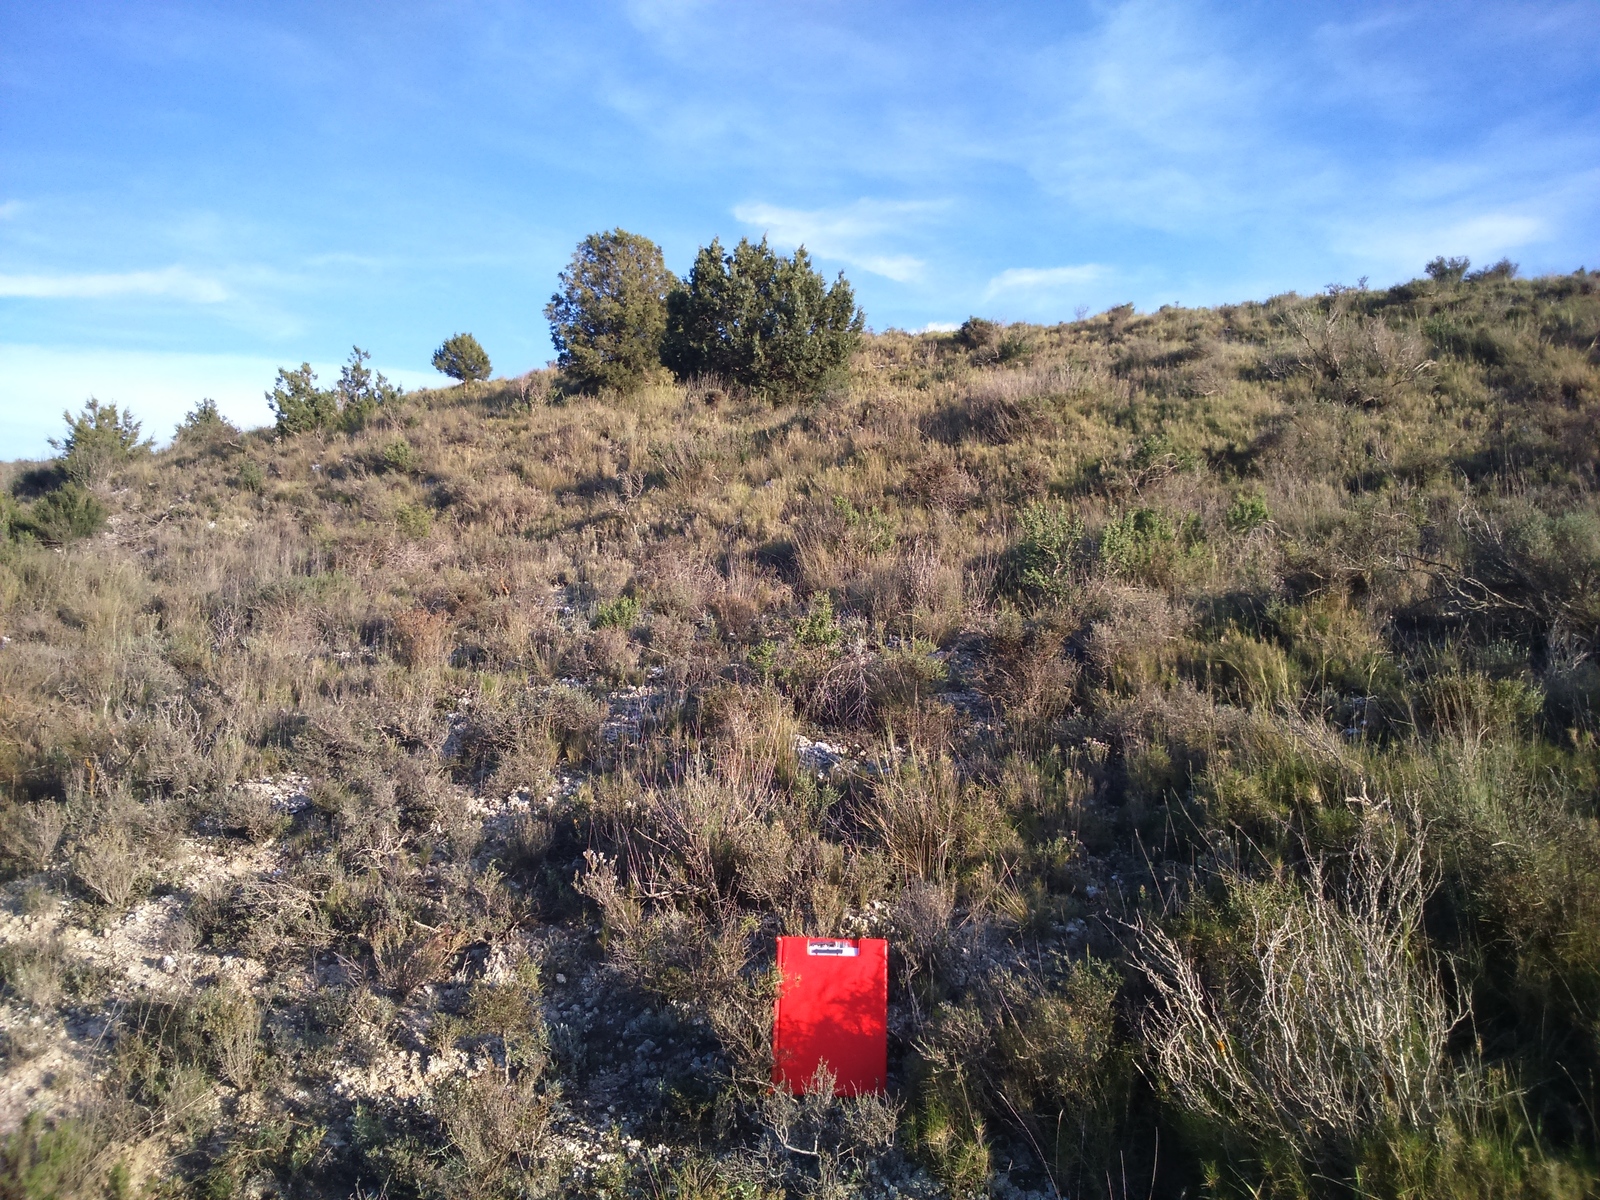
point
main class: Shrubland
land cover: Shrubland with sparse tree cover
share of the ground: > 75 %
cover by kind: shrubs 80 %, herbaceous plants 15 %, coniferous forest trees 5 %
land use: Semi-natural and natural areas not in use
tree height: < 5 m
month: April
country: ES
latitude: 41.4340
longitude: -0.3198
